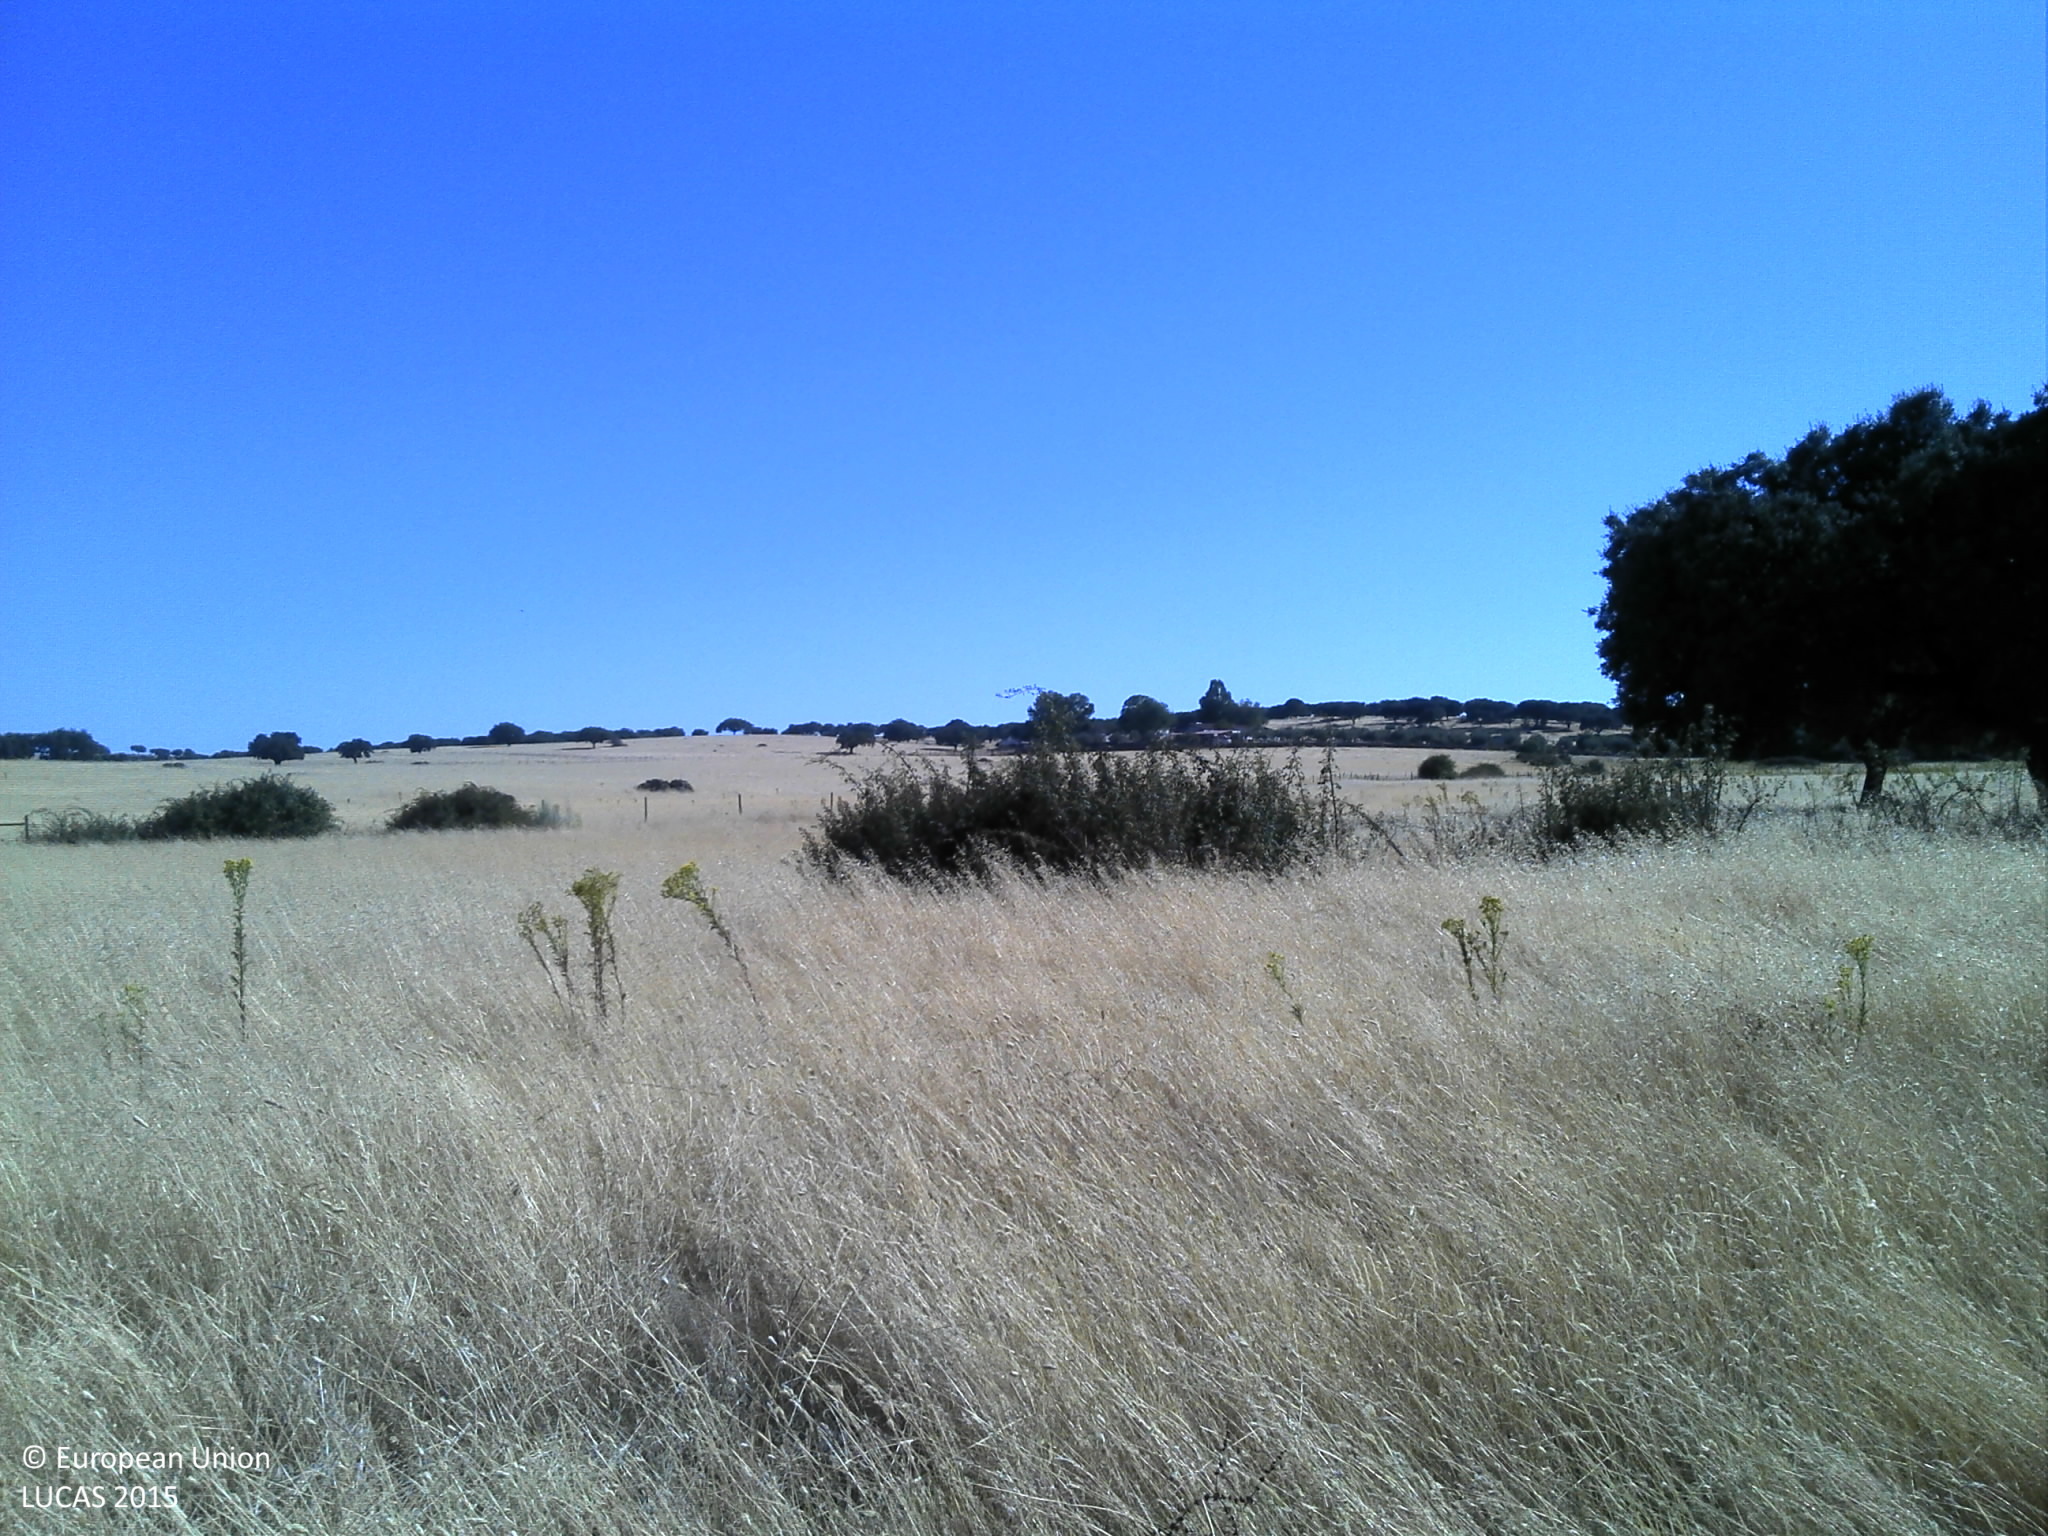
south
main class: Grassland
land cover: Grassland without tree/shrub cover
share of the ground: > 75 %
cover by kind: herbaceous plants 80 %, unconsolidated bare surface 20 %
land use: Agriculture (excluding fallow land and kitchen gardens)
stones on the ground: < 10 %
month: July
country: PT
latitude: 39.1184
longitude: -7.3271
